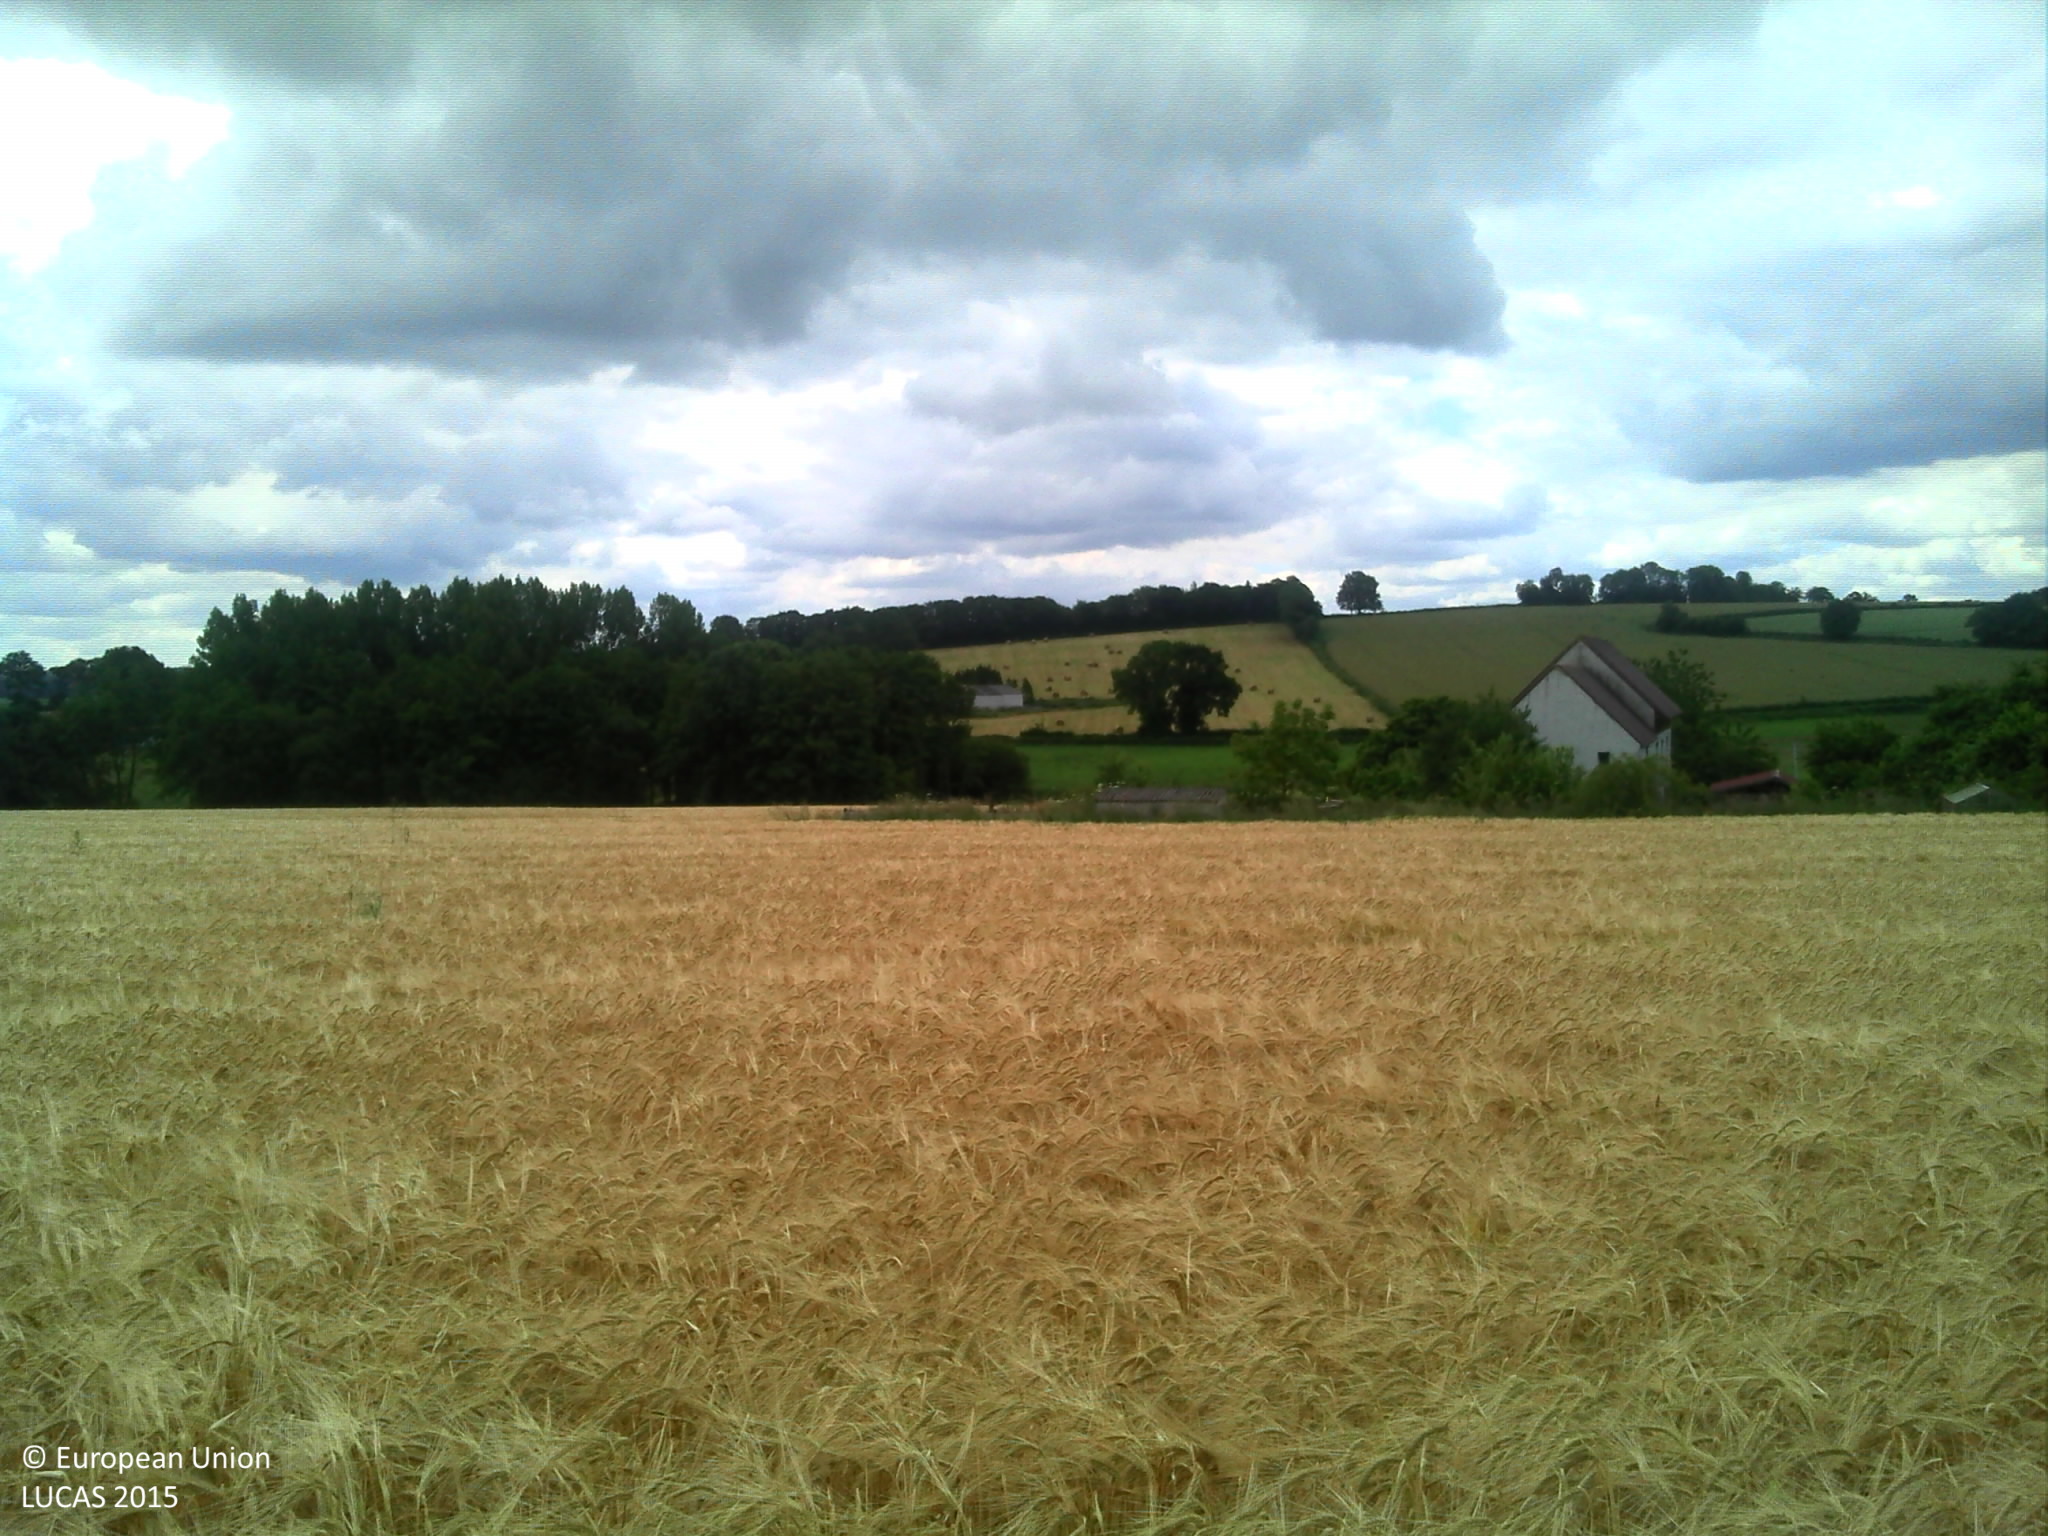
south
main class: Cropland
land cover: Barley
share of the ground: > 75 %
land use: Agriculture (excluding fallow land and kitchen gardens)
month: June
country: FR
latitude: 48.7068
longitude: -0.2380
